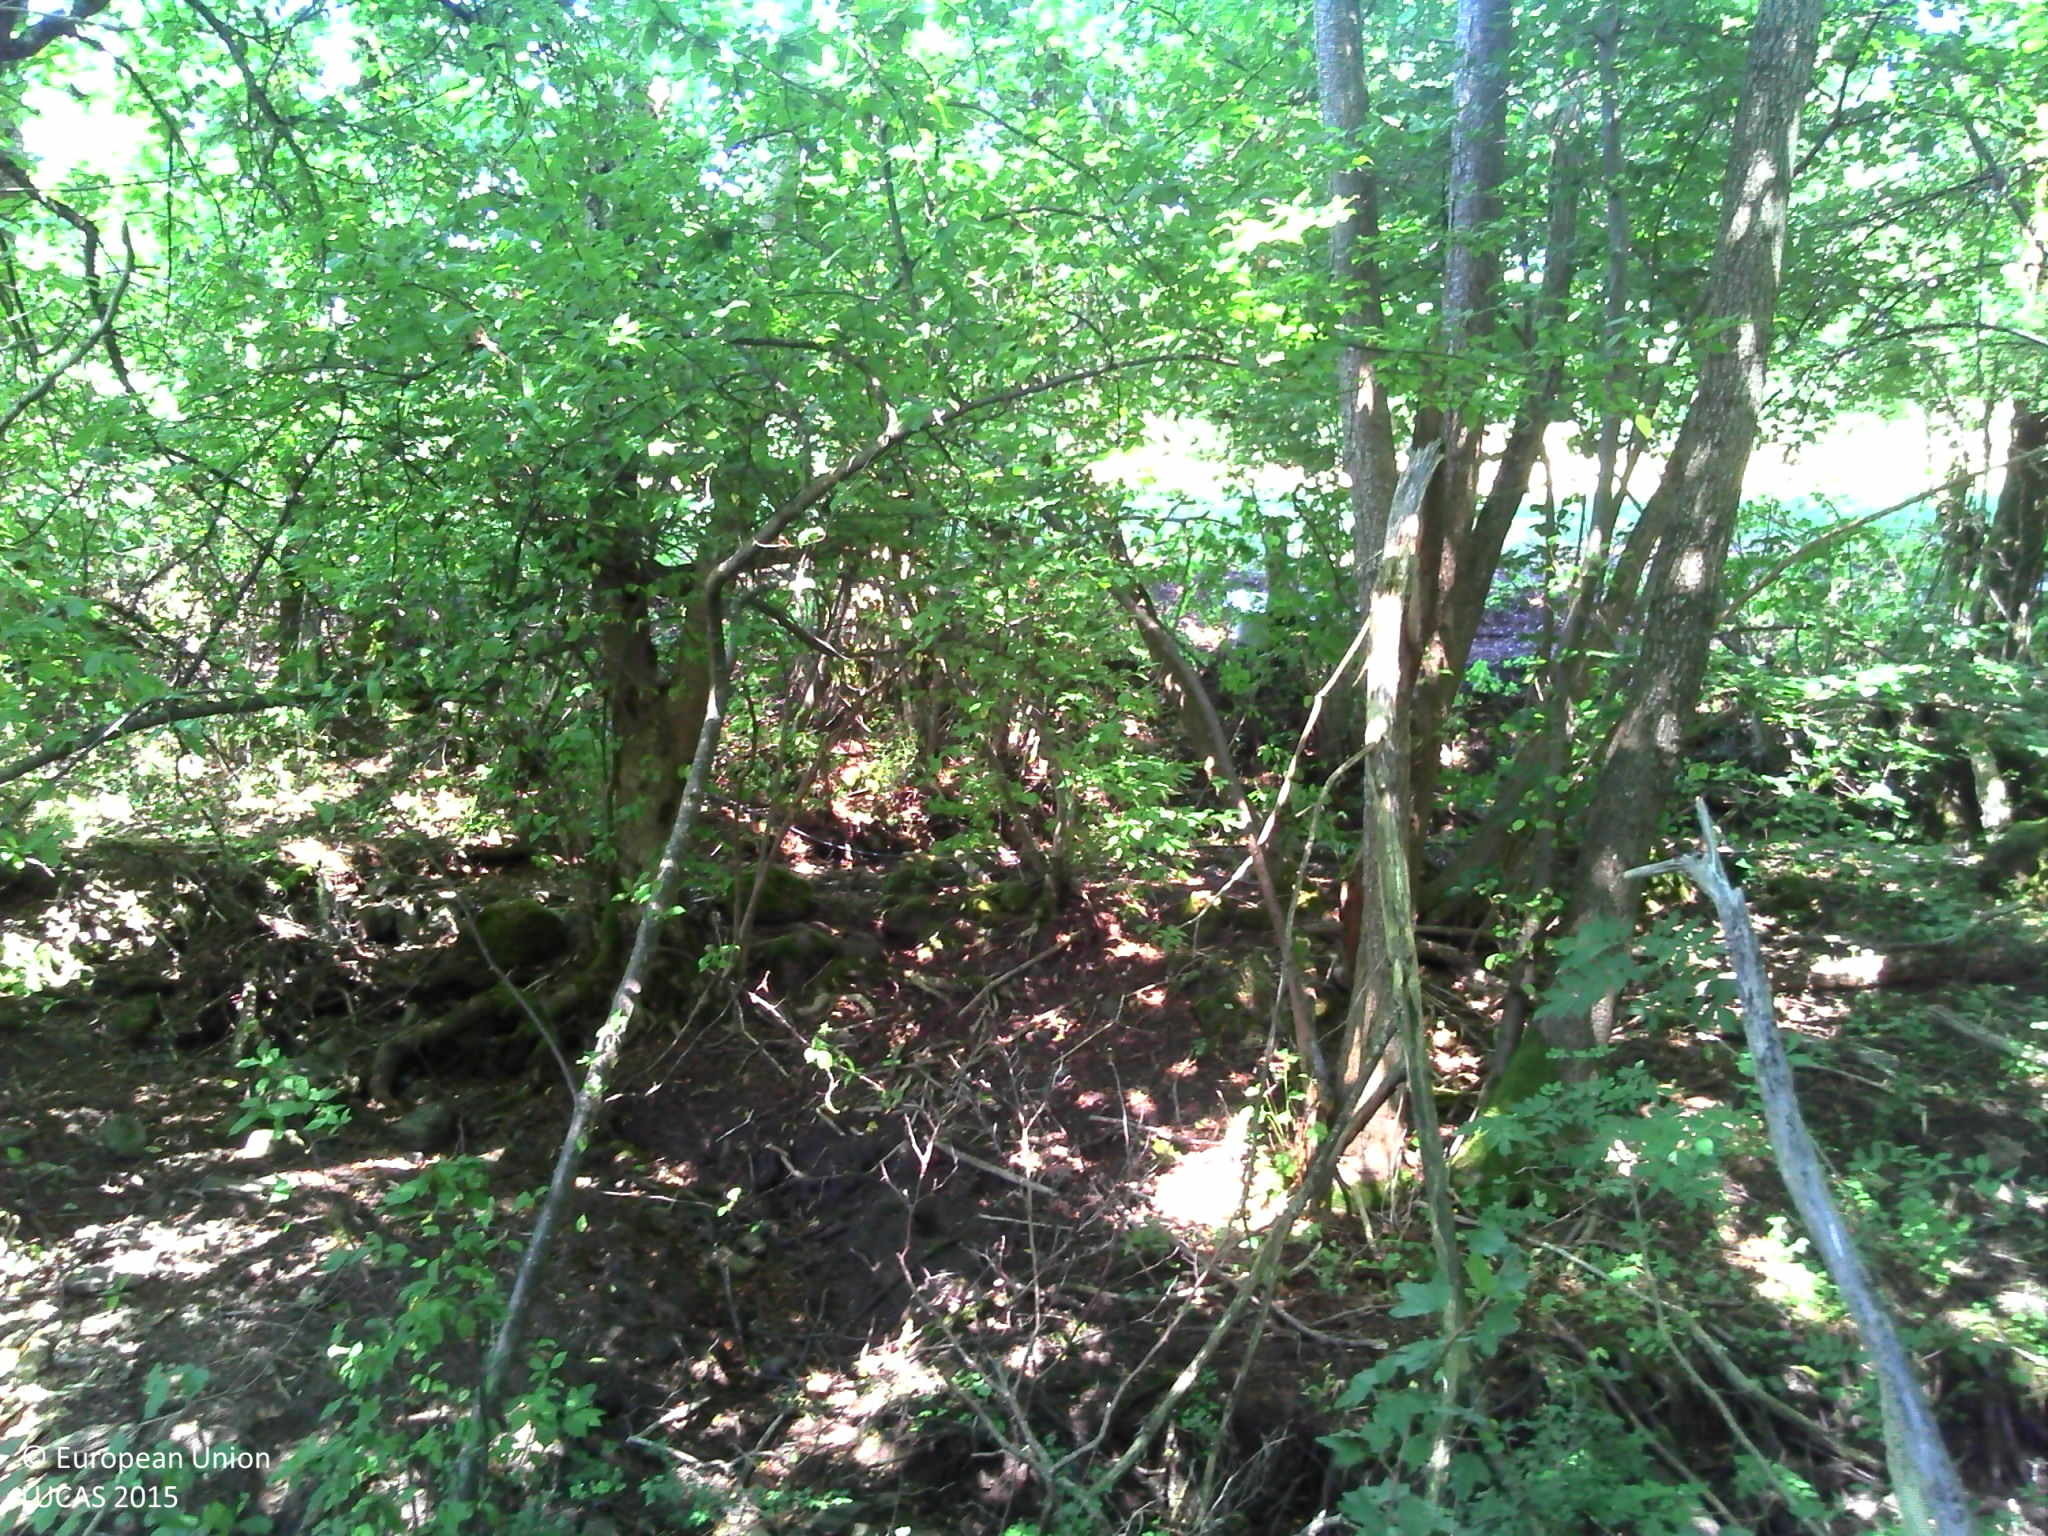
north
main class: Woodland
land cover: Broadleaved woodland
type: mesophytic deciduous forest
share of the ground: > 75 %
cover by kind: broadleaved forest trees 50 %, herbaceous plants 30 %, unconsolidated bare surface 20 %
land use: Agriculture (excluding fallow land and kitchen gardens)
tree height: > 5 m
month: August
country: FR
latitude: 45.6991
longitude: 2.8971
